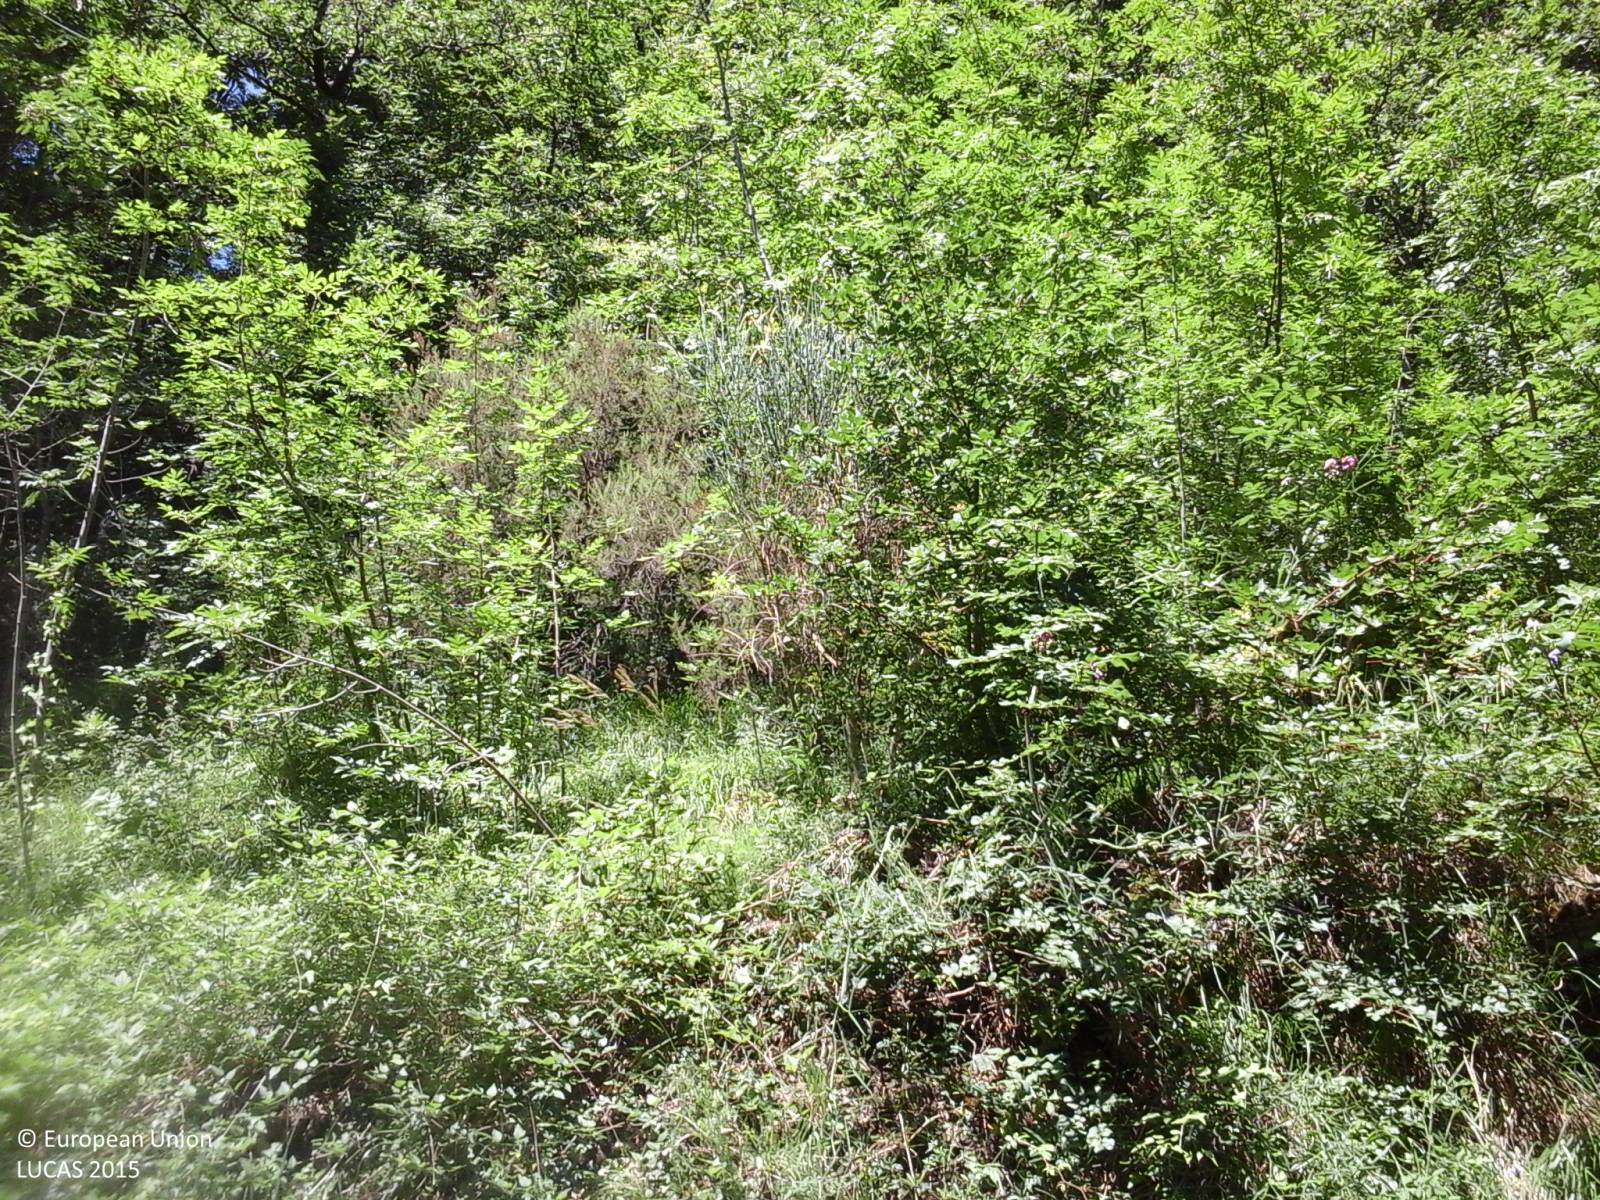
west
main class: Woodland
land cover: Broadleaved woodland
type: thermophilous deciduous forest
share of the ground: > 75 %
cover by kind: broadleaved forest trees 100 %
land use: Forestry
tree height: > 5 m
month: June
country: IT
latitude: 44.3685
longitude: 9.9124
